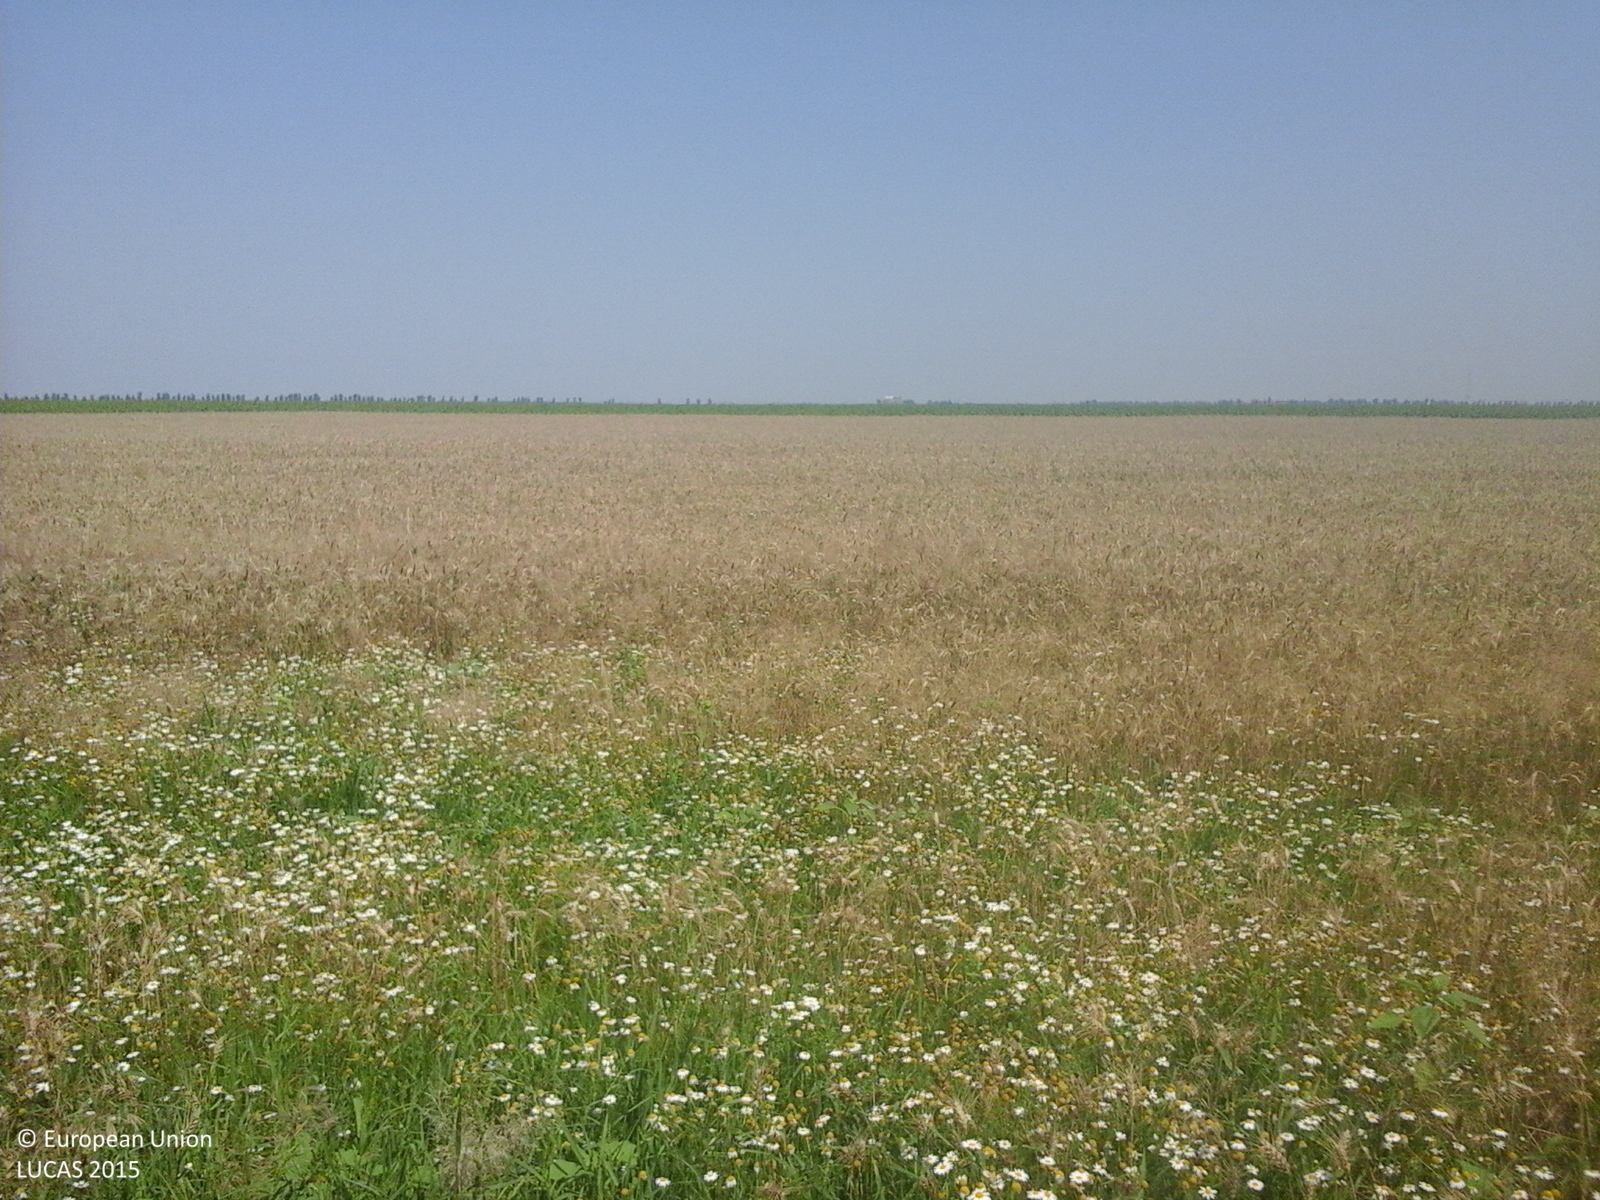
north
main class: Cropland
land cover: Common wheat
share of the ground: > 75 %
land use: Agriculture (excluding fallow land and kitchen gardens)
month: July
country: RO
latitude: 44.3210
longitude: 24.9620
